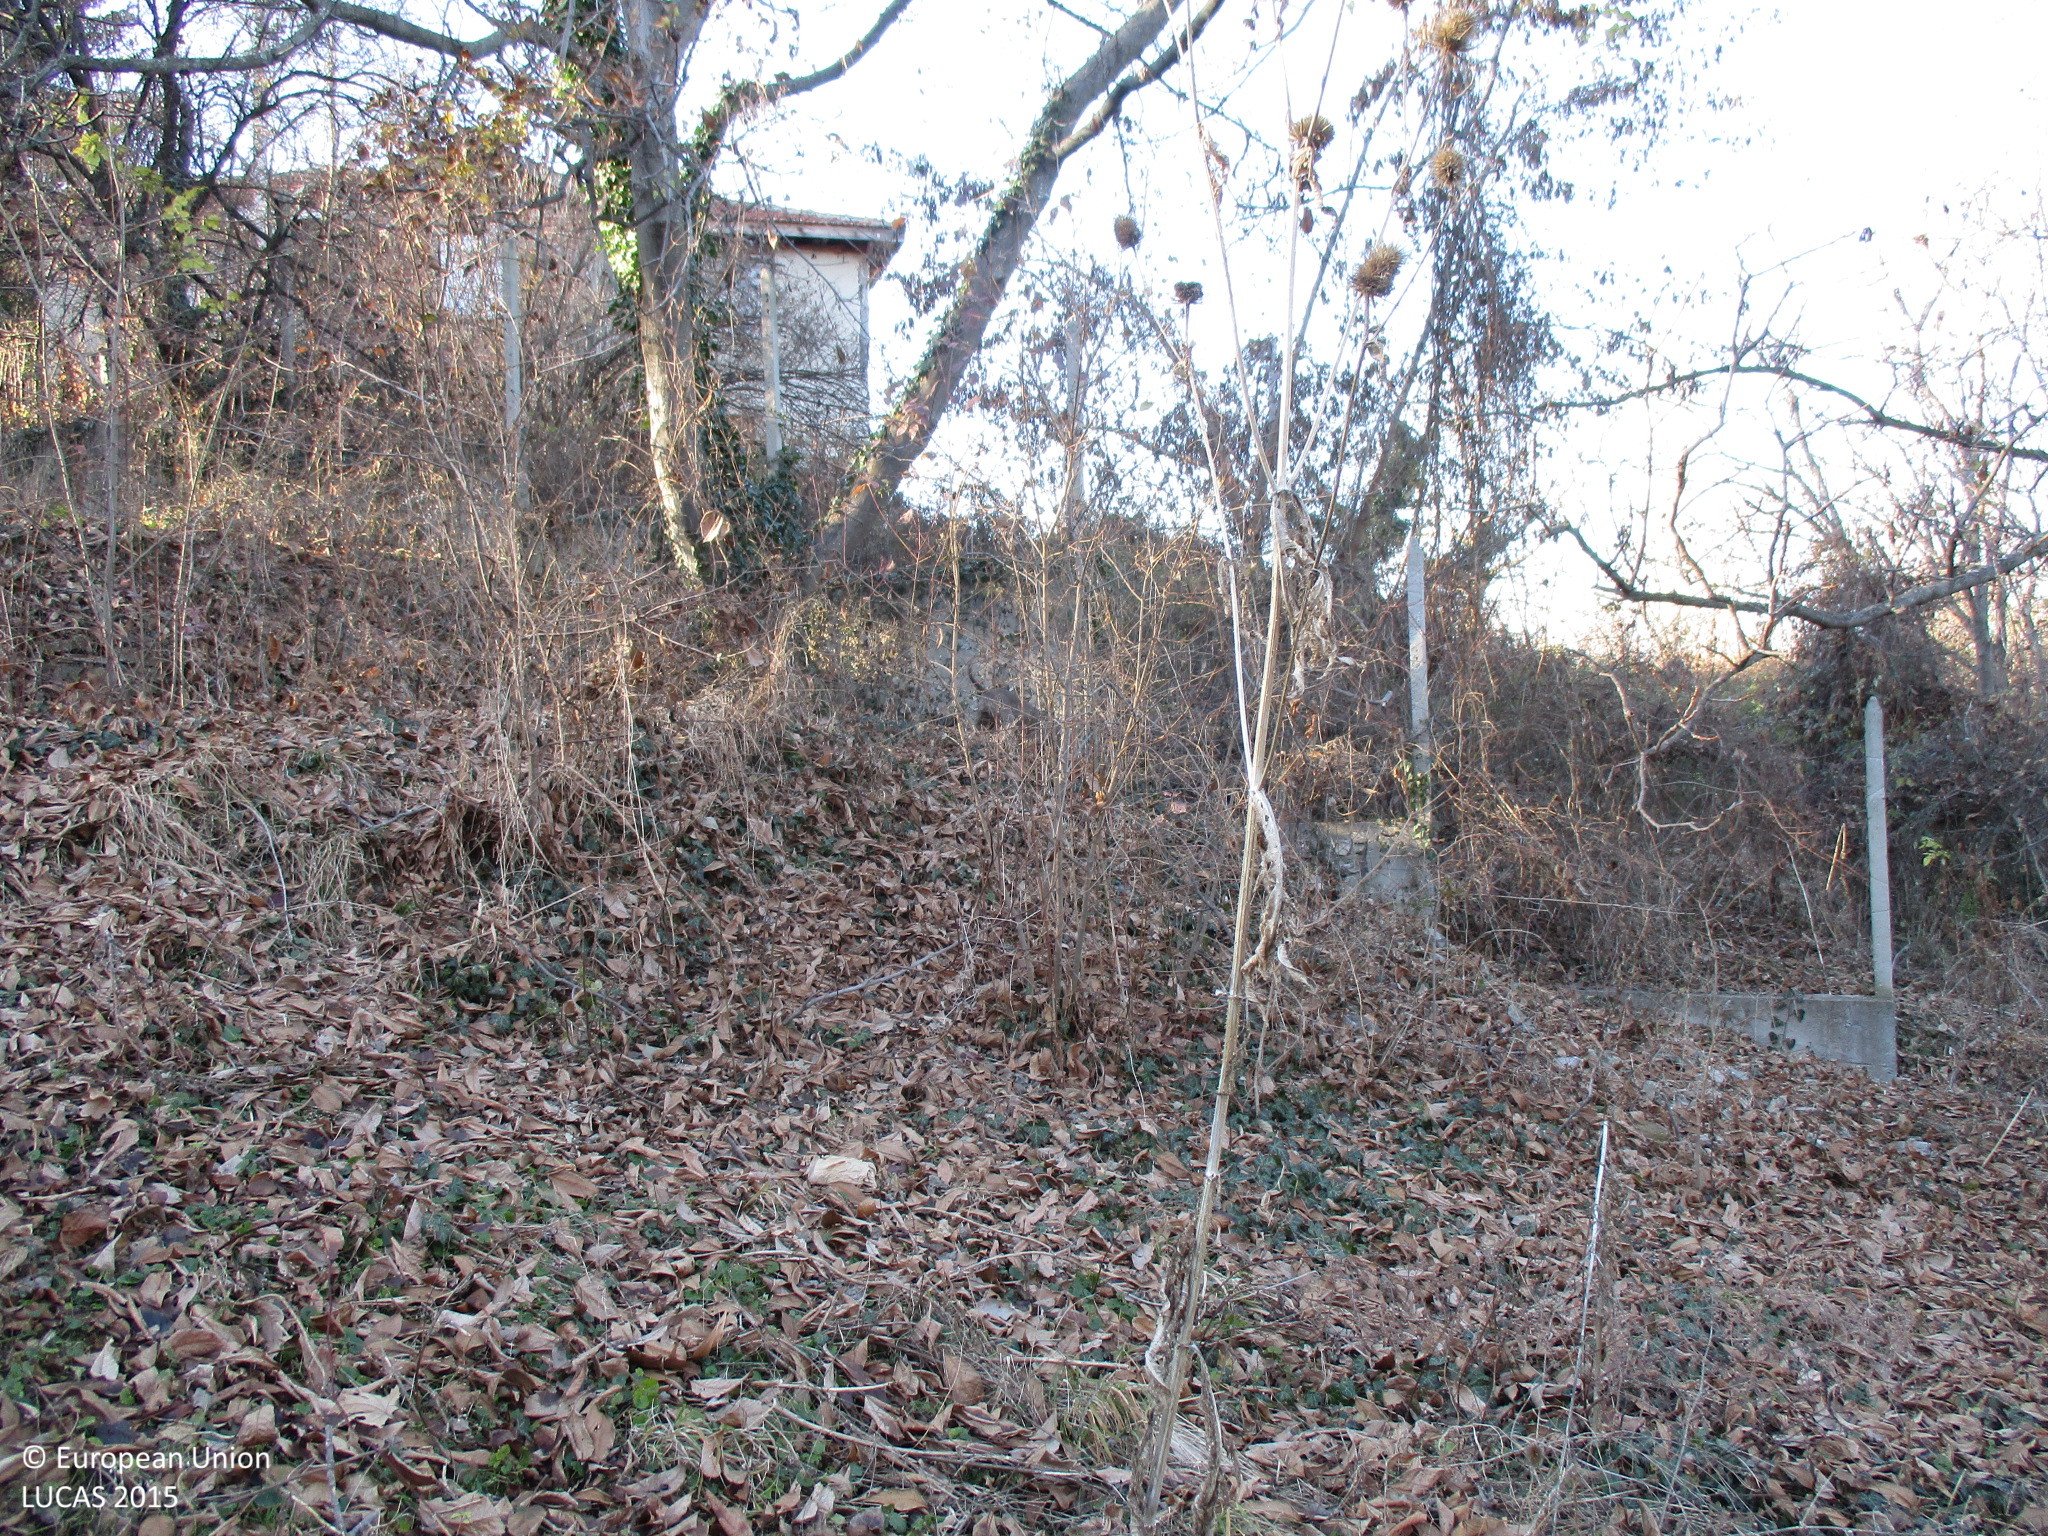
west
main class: Woodland
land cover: Broadleaved woodland
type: mesophytic deciduous forest
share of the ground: > 75 %
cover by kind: broadleaved forest trees 90 %, shrubs 10 %
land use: Semi-natural and natural areas not in use
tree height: > 5 m
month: December
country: BG
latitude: 42.0363
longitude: 24.6774
